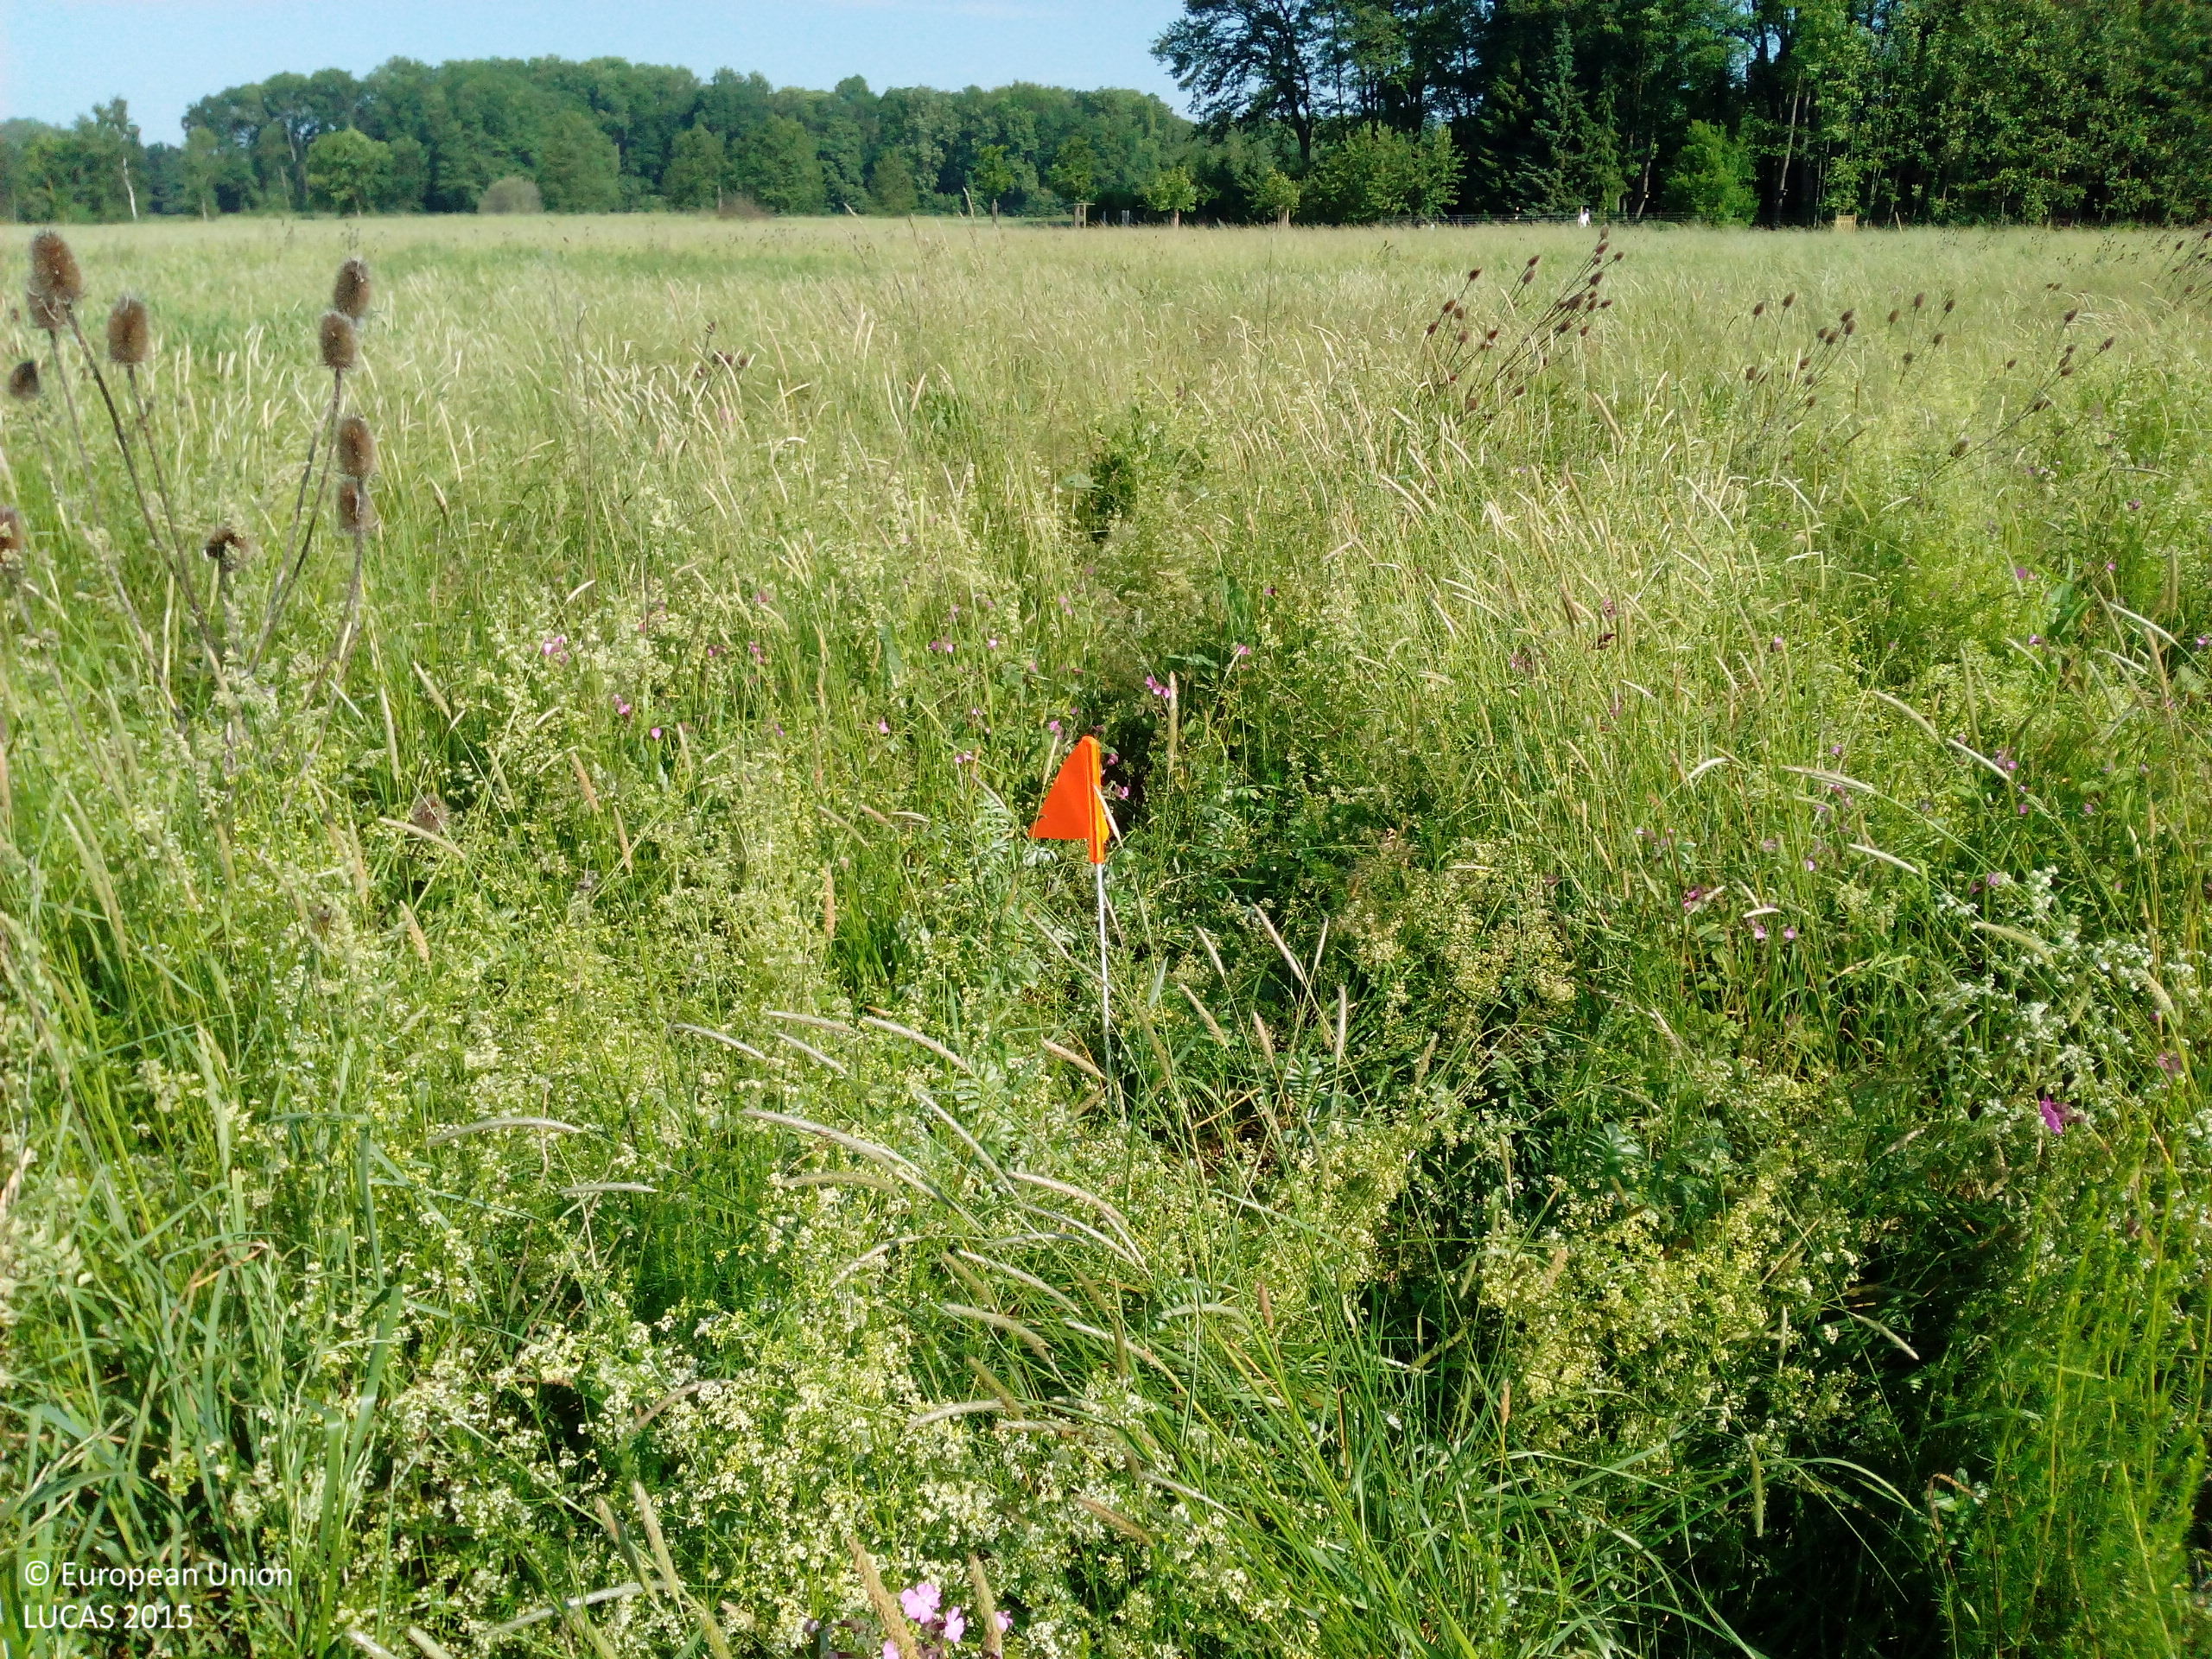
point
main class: Grassland
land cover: Spontaneously vegetated surfaces
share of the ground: > 75 %
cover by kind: herbaceous plants 100 %
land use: Fallow land
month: June
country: DE
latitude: 48.9171
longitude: 12.4147
